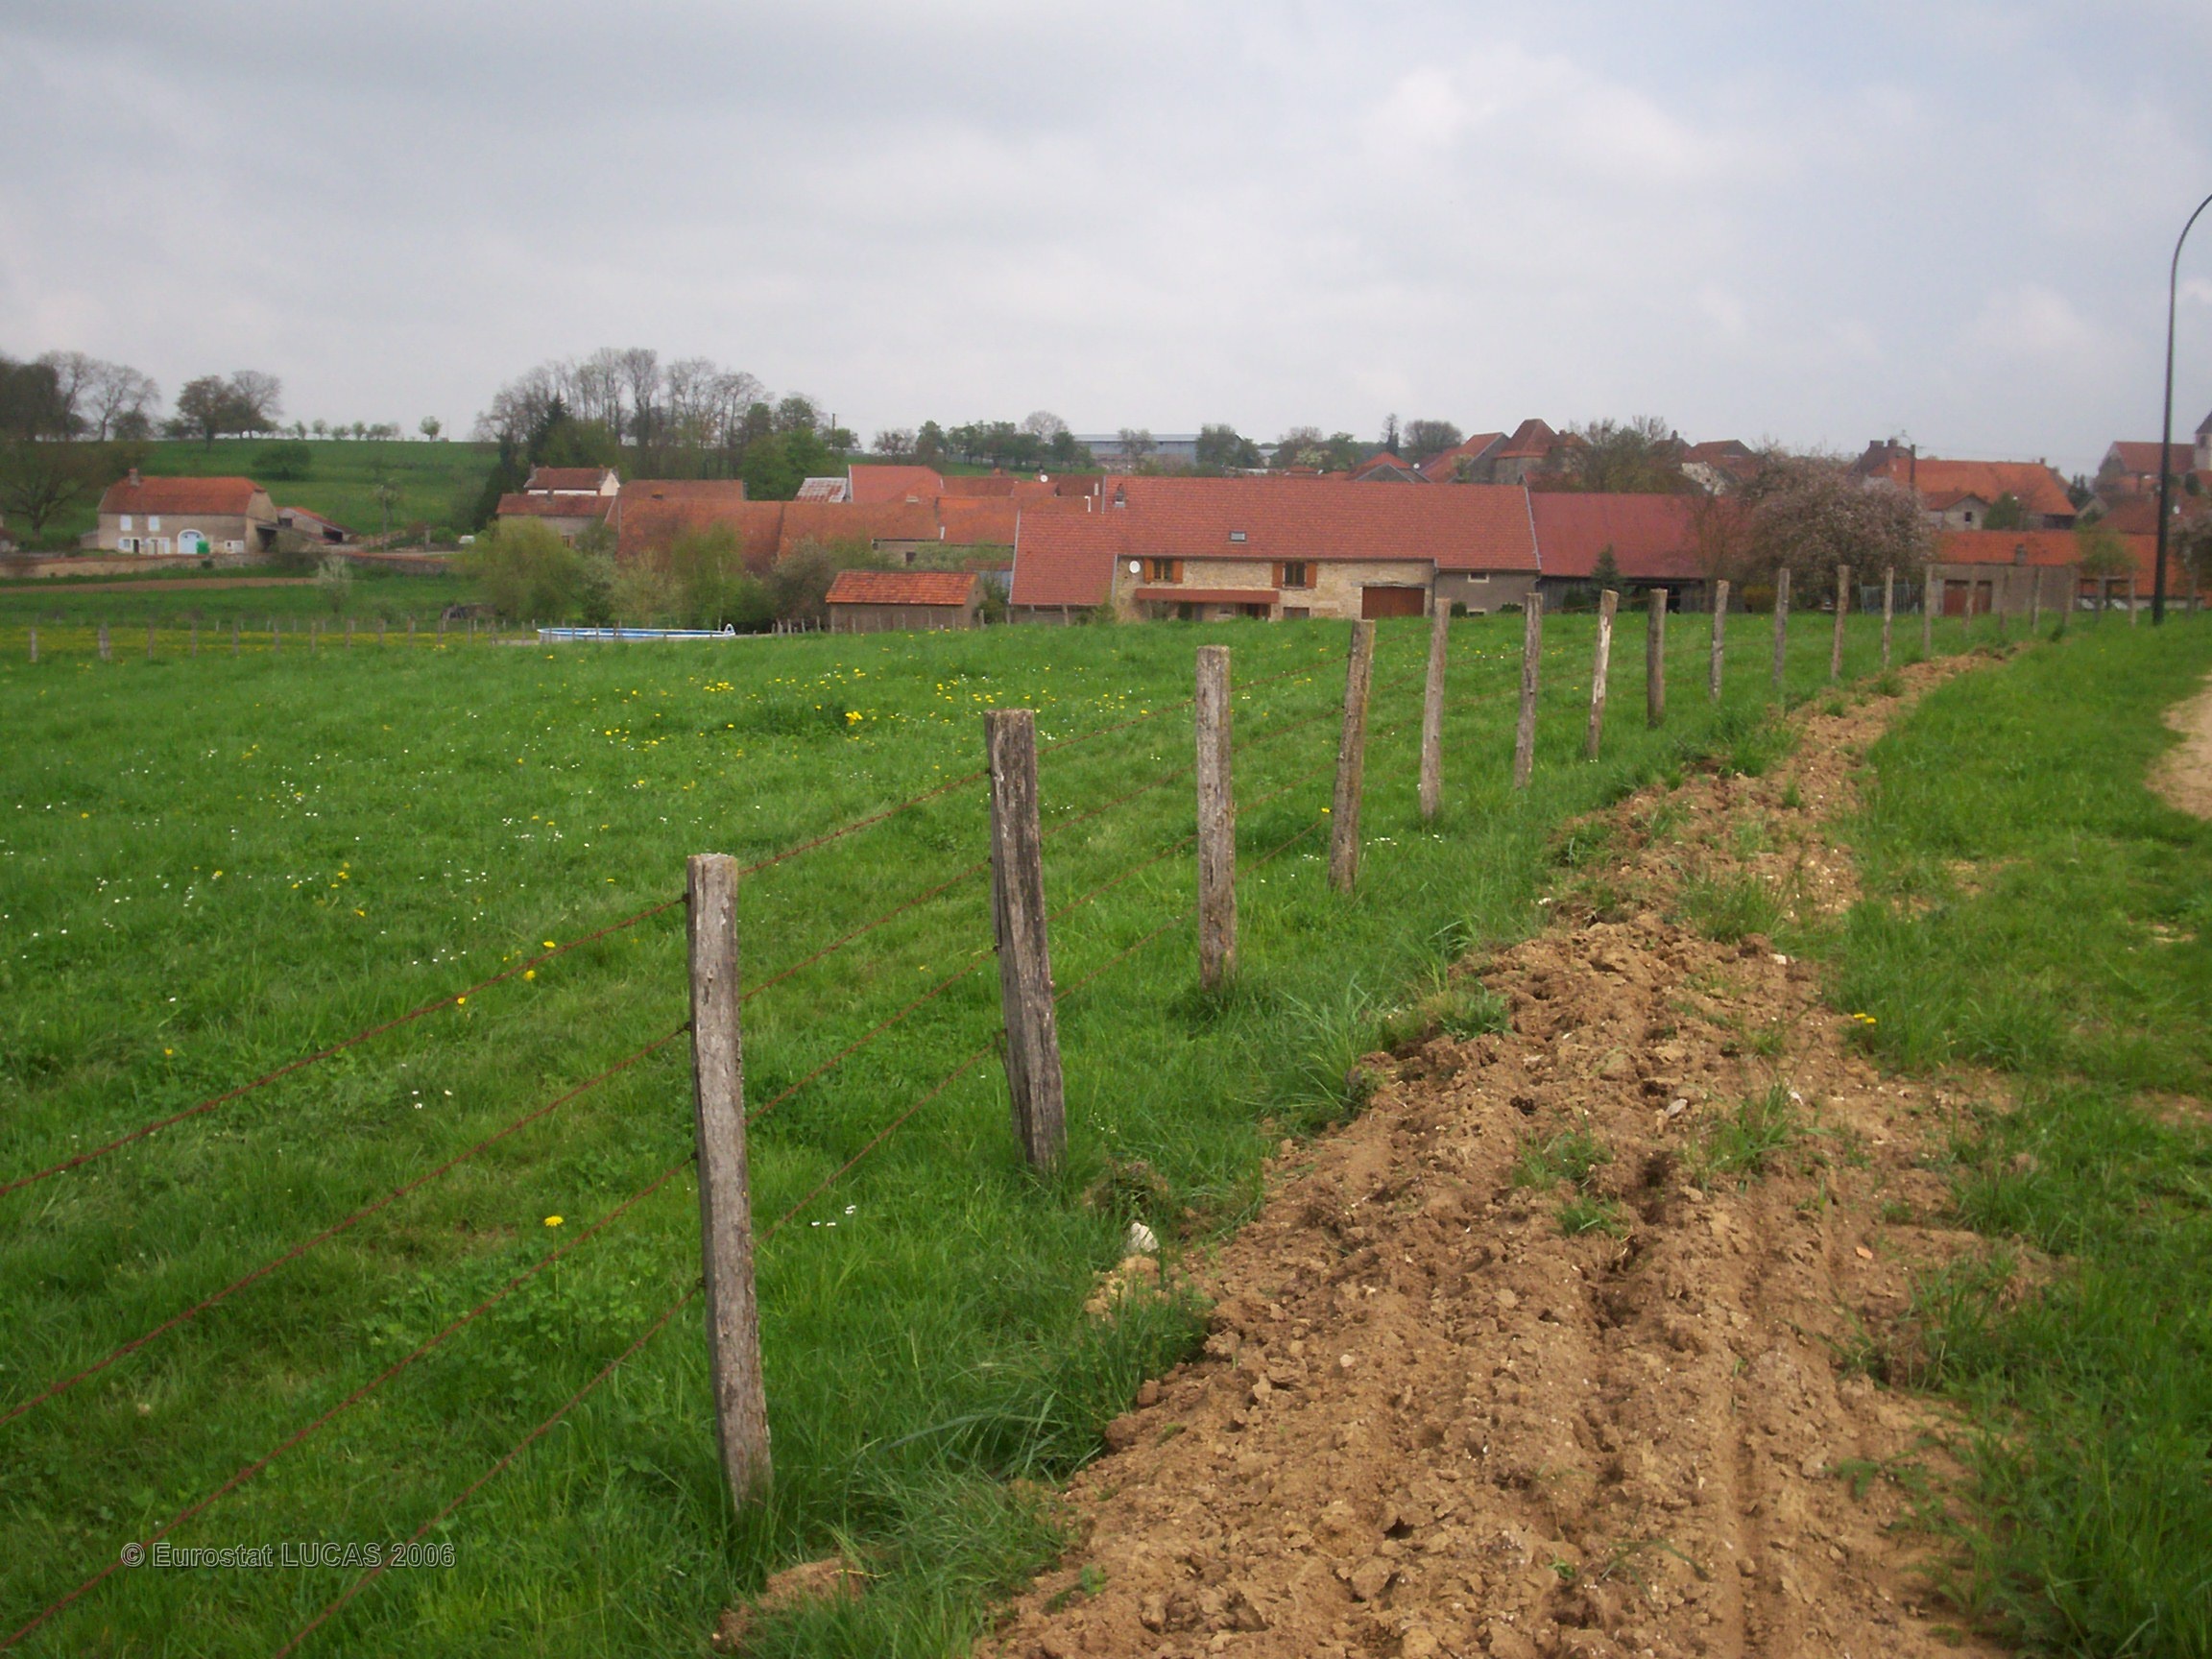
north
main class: Grassland
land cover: Grassland without tree/shrub cover
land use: Agriculture (excluding fallow land and kitchen gardens)
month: April
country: FR
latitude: 47.6103
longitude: 5.9969
